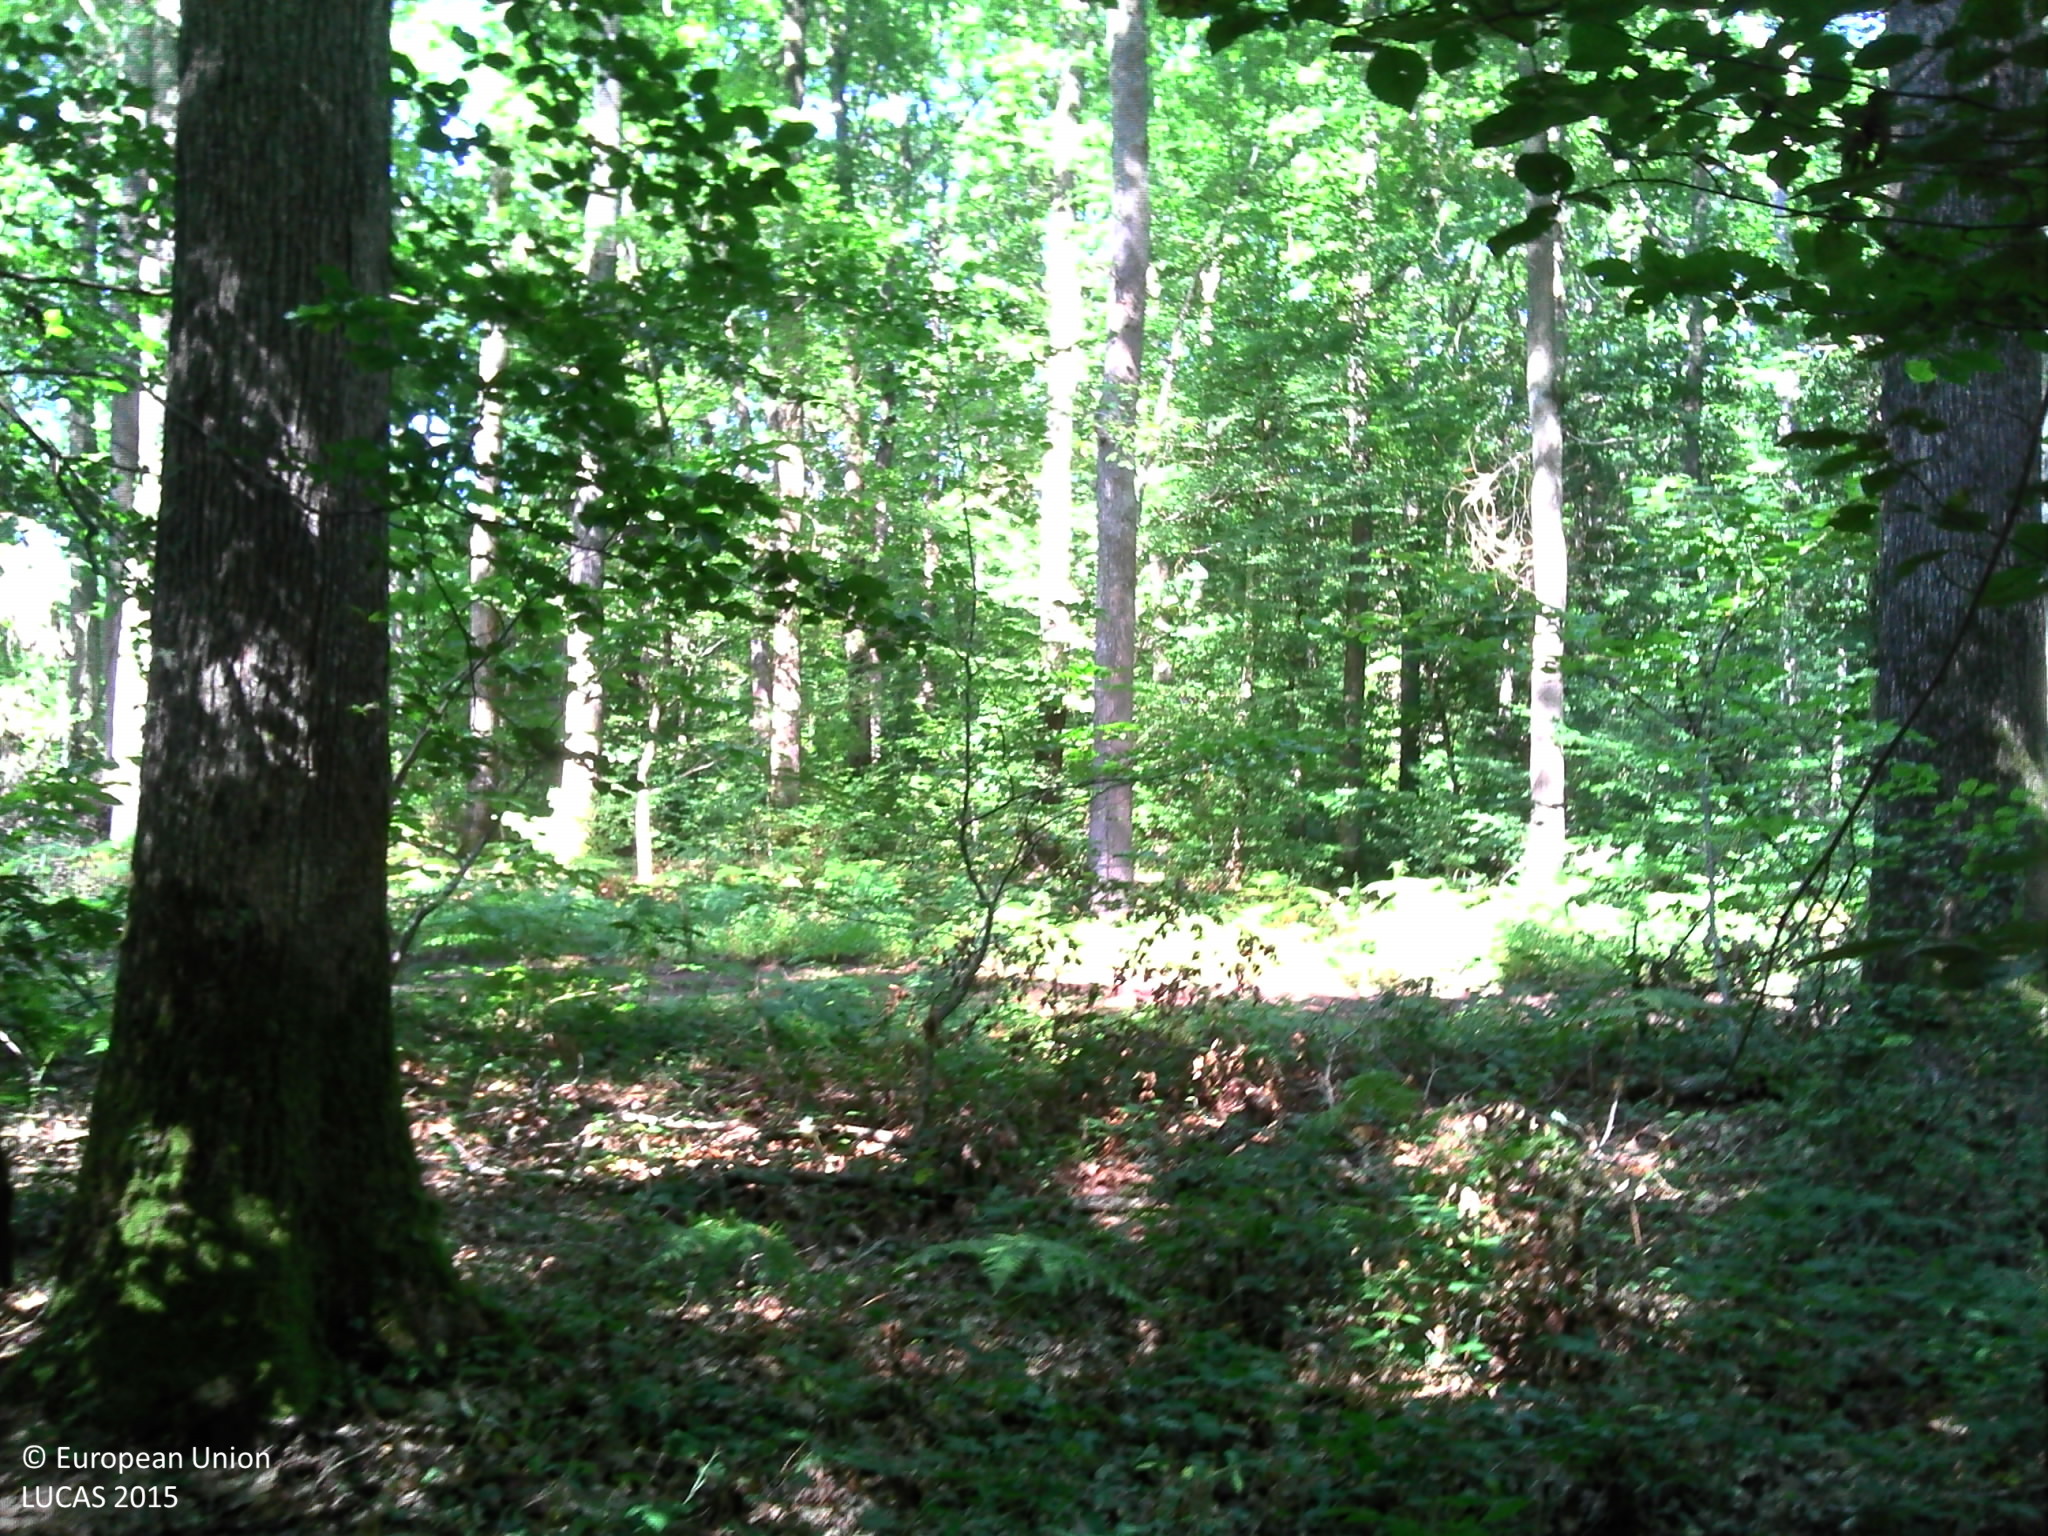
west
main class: Woodland
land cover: Broadleaved woodland
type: mesophytic deciduous forest
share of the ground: > 75 %
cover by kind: broadleaved forest trees 95 %, herbaceous plants 5 %
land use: Forestry
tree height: > 5 m
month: August
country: FR
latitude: 46.6309
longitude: 2.7728
